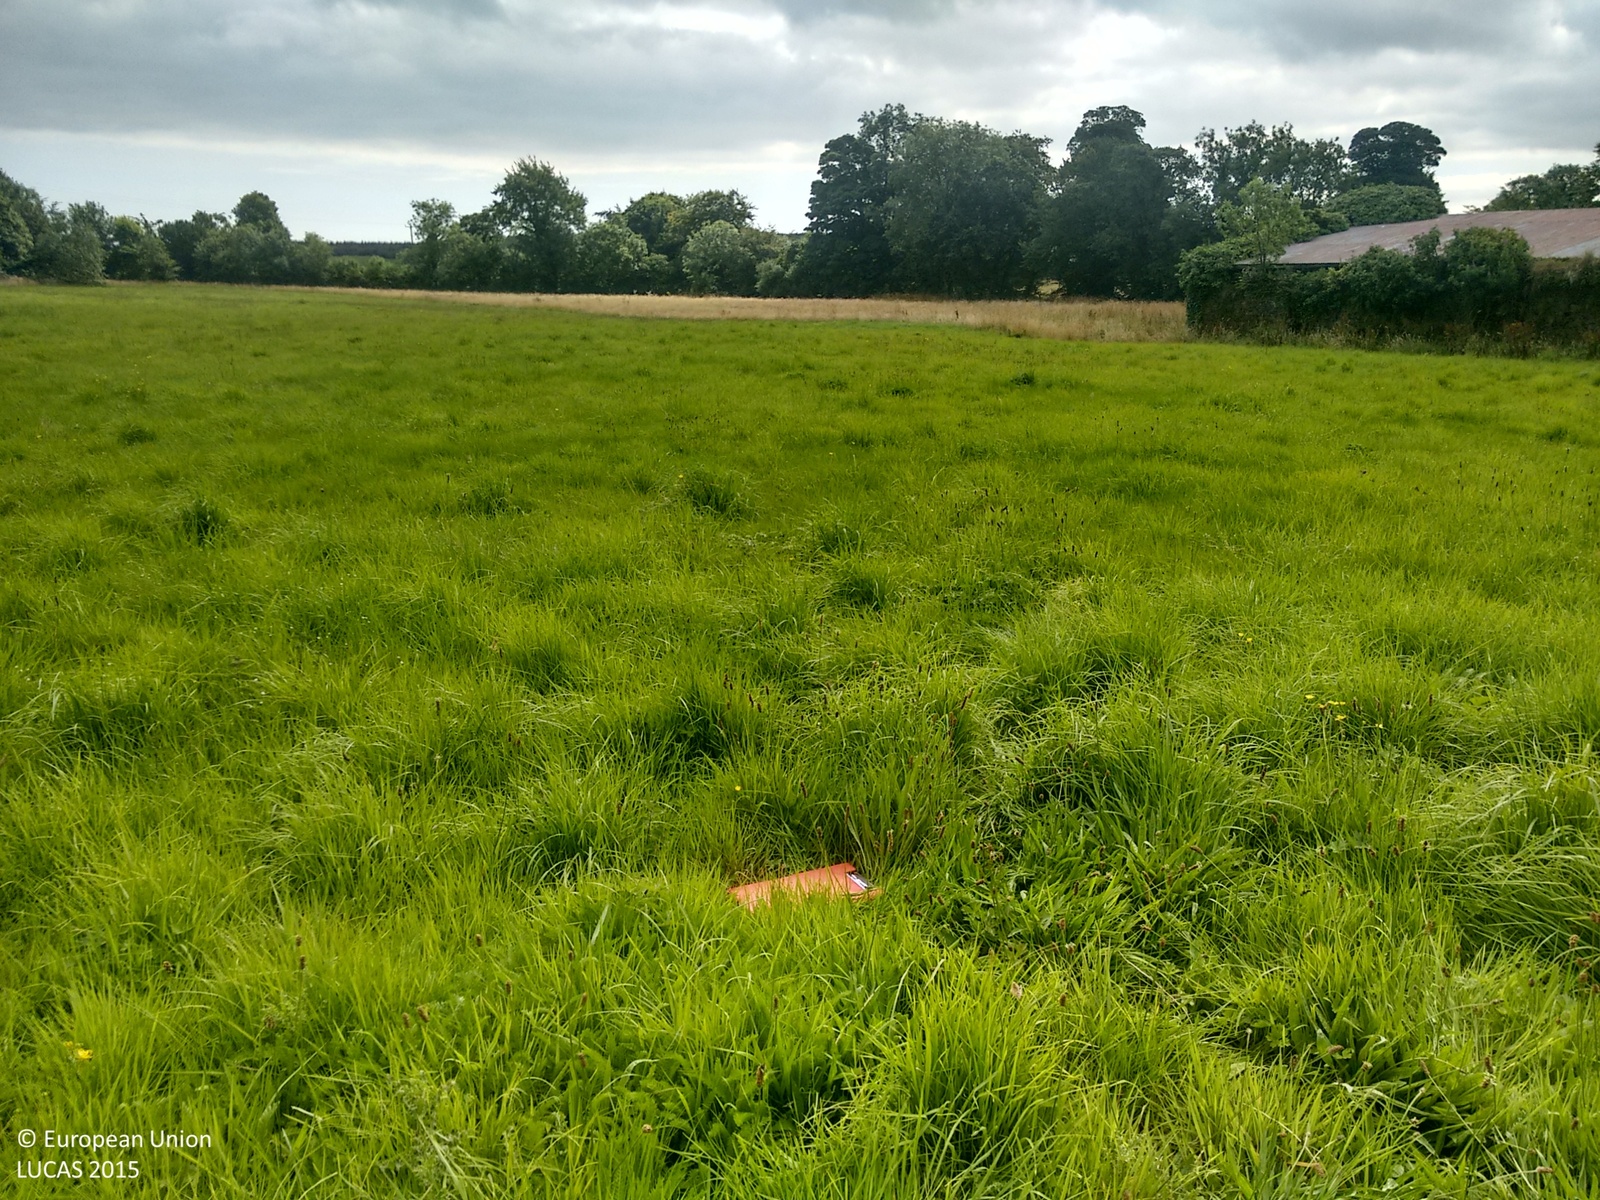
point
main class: Grassland
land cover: Grassland without tree/shrub cover
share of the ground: > 75 %
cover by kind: herbaceous plants 100 %
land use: Agriculture (excluding fallow land and kitchen gardens)
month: August
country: IE
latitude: 53.8000
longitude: -6.3835
